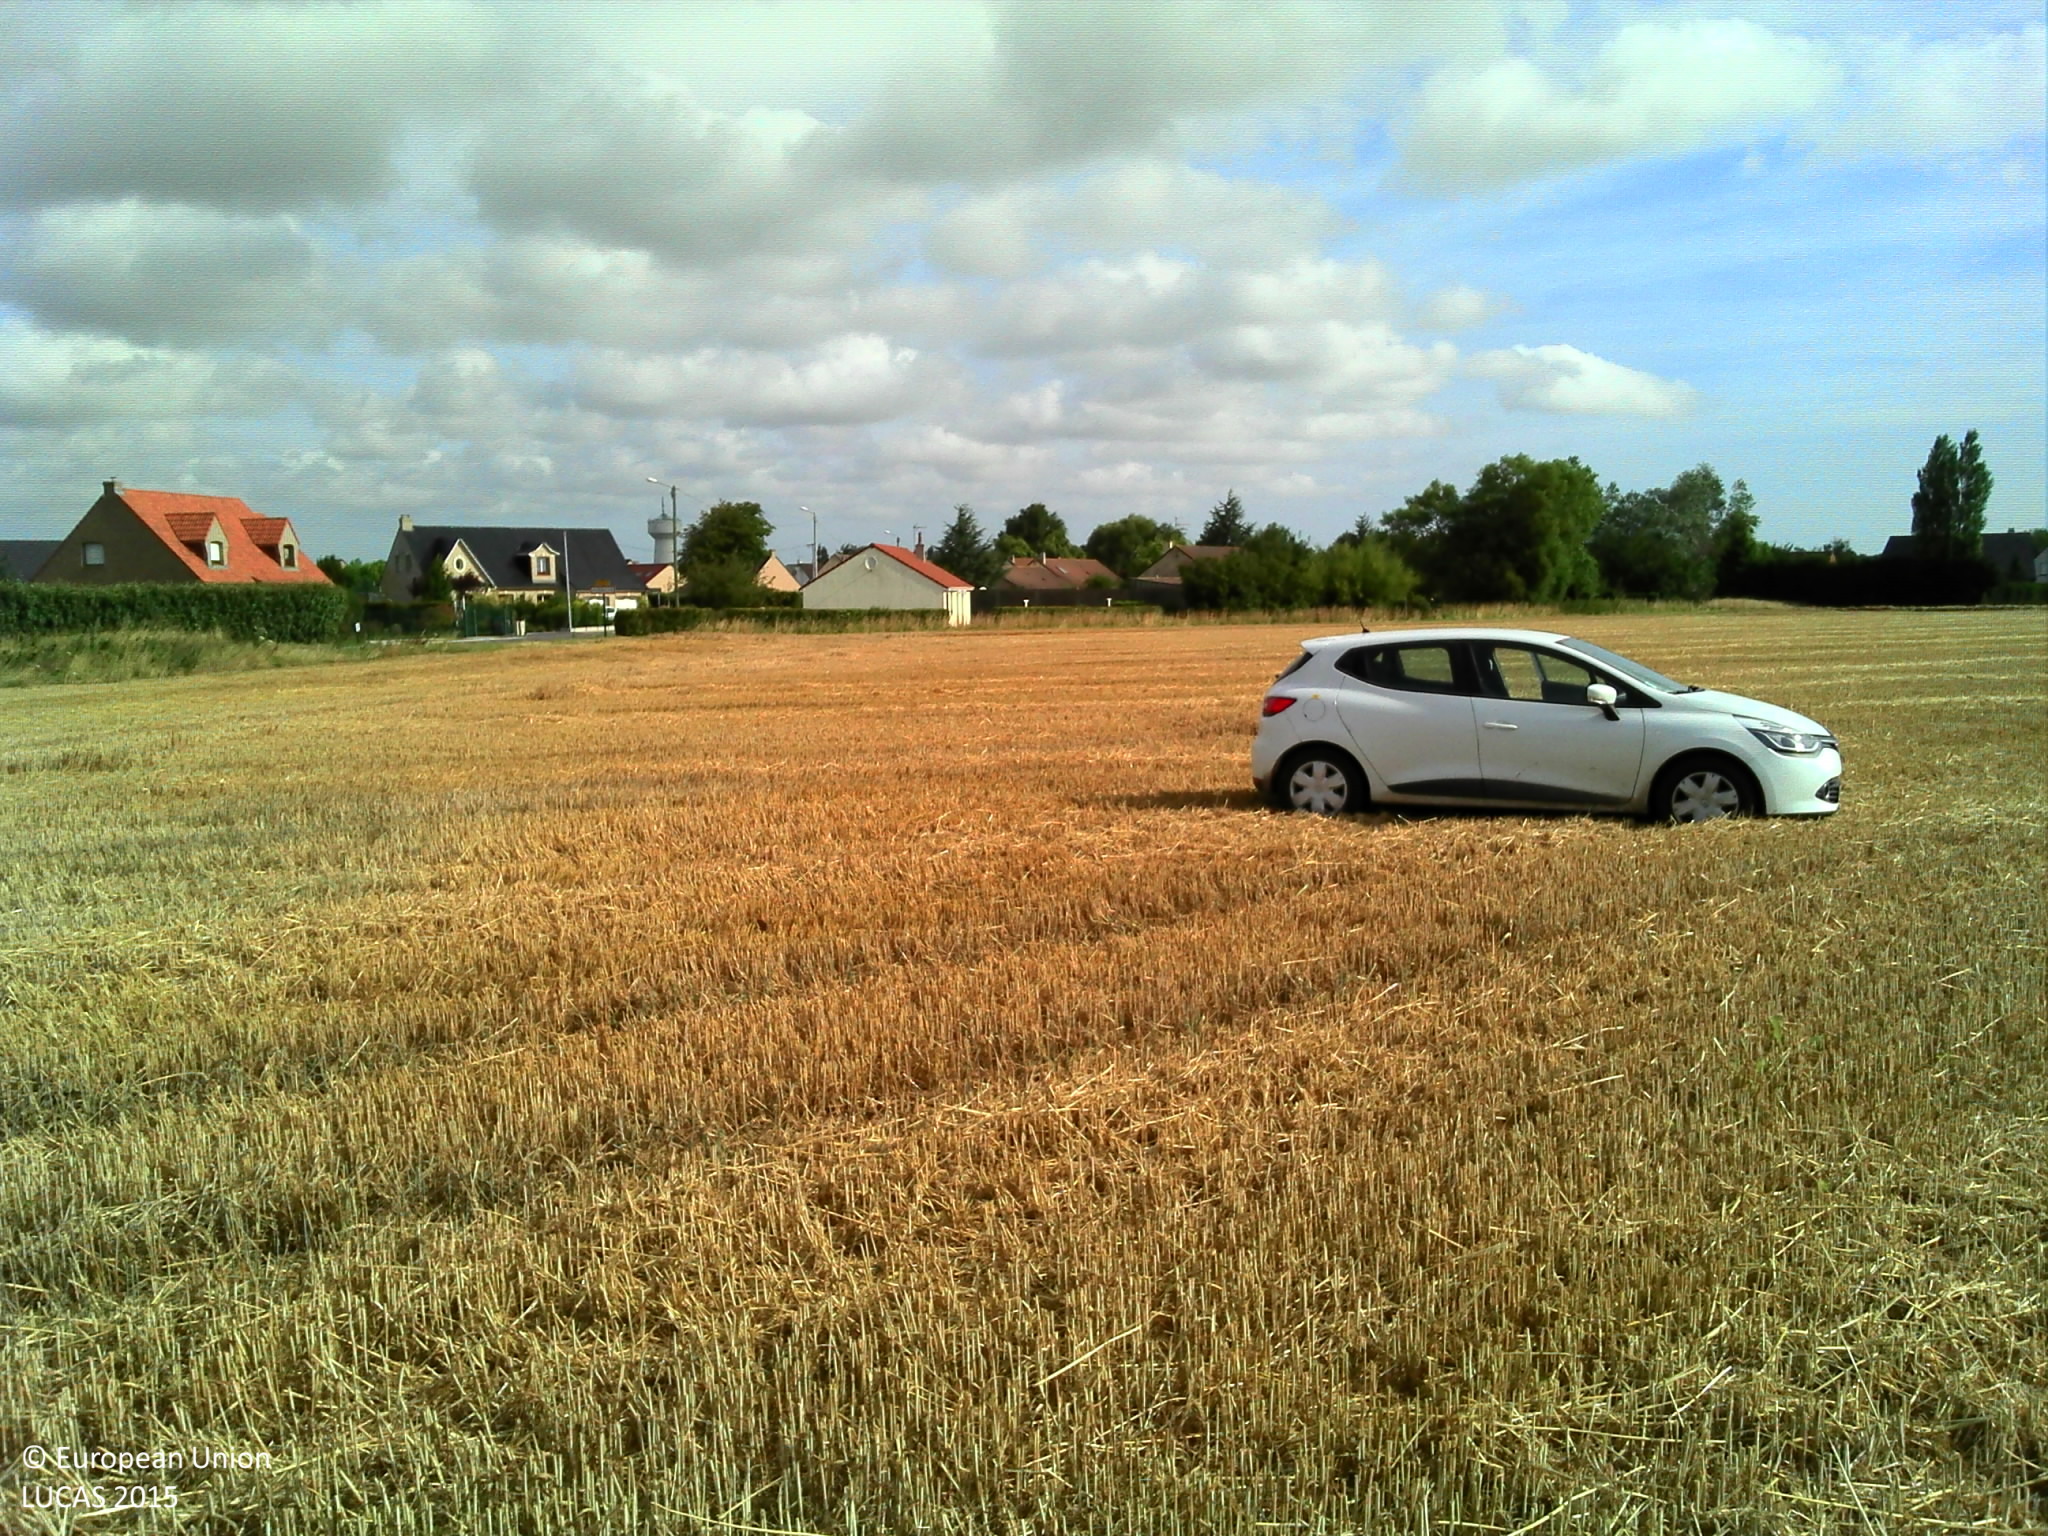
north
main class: Cropland
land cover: Common wheat
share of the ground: 50 - 75 %
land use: Agriculture (excluding fallow land and kitchen gardens)
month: August
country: FR
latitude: 50.8655
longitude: 2.0704
